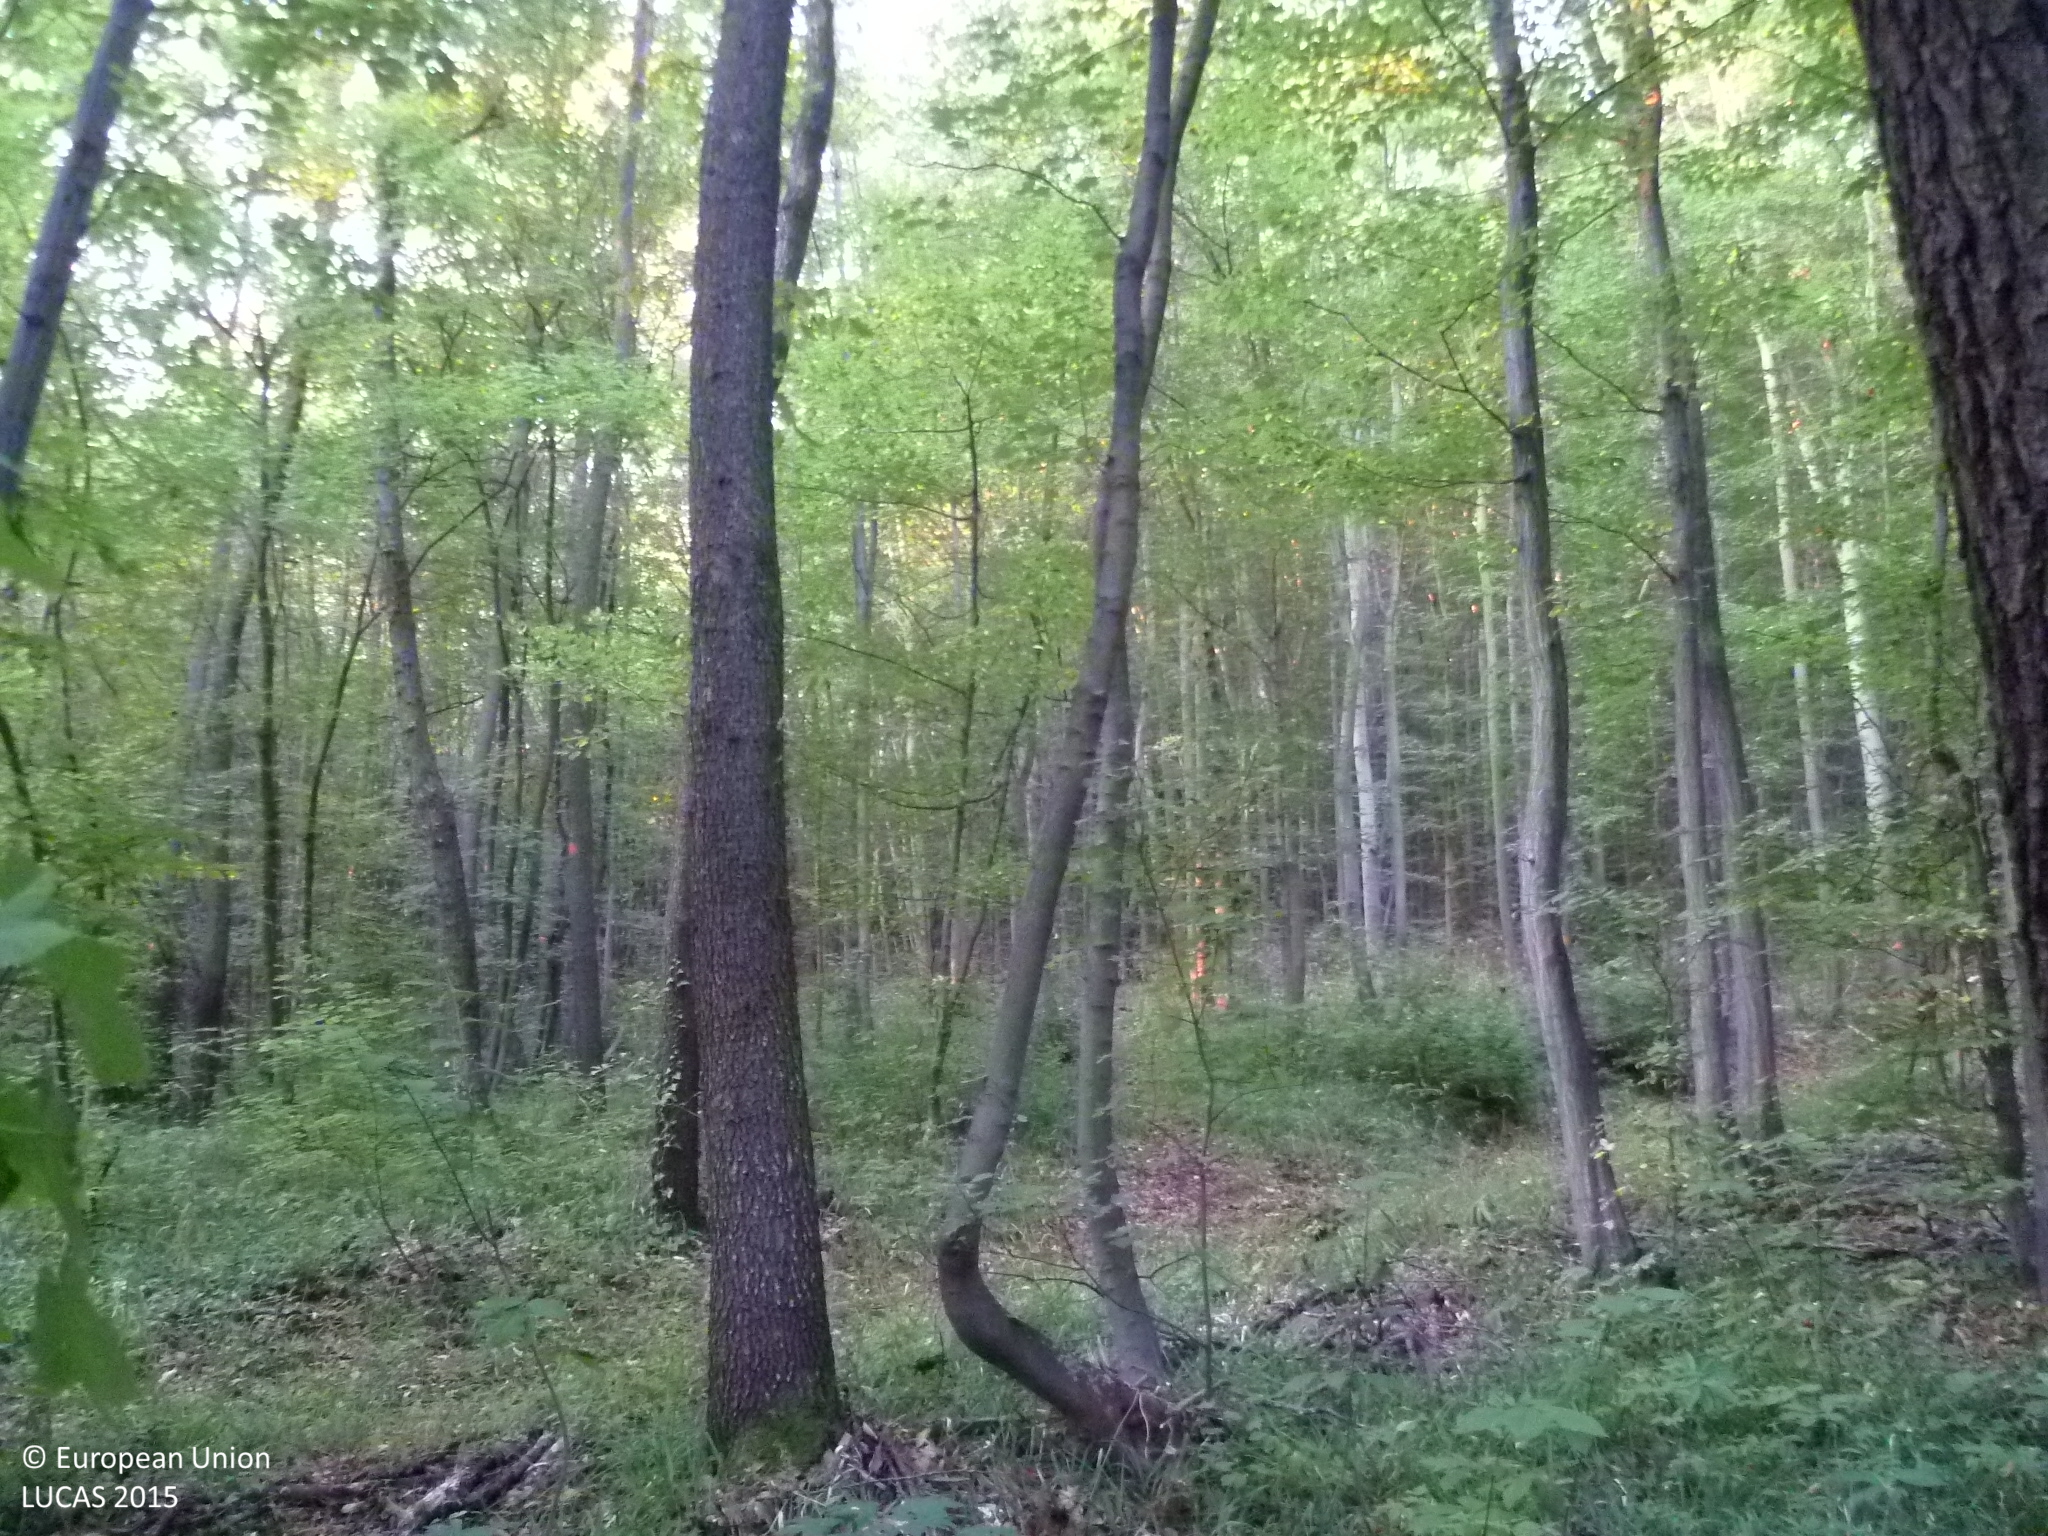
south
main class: Woodland
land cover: Broadleaved woodland
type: mesophytic deciduous forest
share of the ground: 50 - 75 %
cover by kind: broadleaved forest trees 65 %, herbaceous plants 30 %, shrubs 5 %
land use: Forestry
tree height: > 5 m
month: September
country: BG
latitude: 42.6666
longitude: 23.1723
